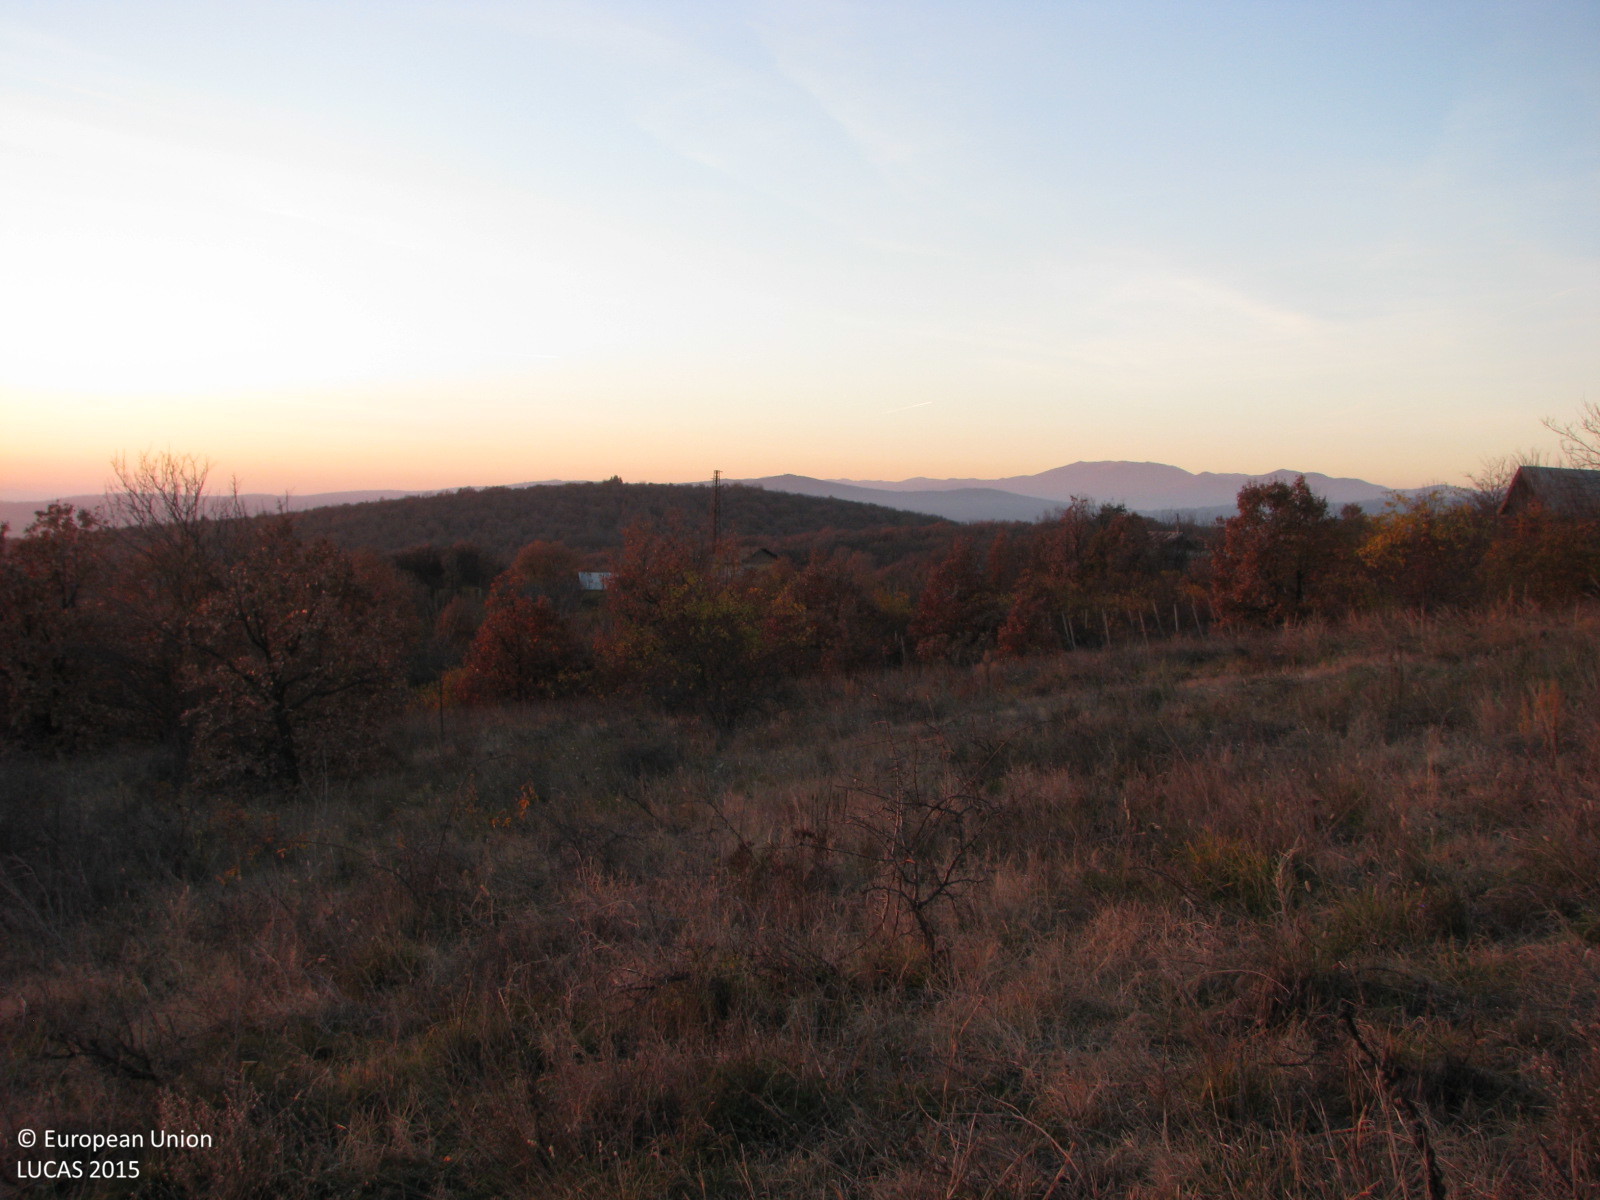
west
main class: Grassland
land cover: Grassland with sparse tree/shrub cover
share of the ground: > 75 %
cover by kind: herbaceous plants 90 %, broadleaved forest trees 5 %, shrubs 5 %
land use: Abandoned areas
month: December
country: BG
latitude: 42.4535
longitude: 24.8303
